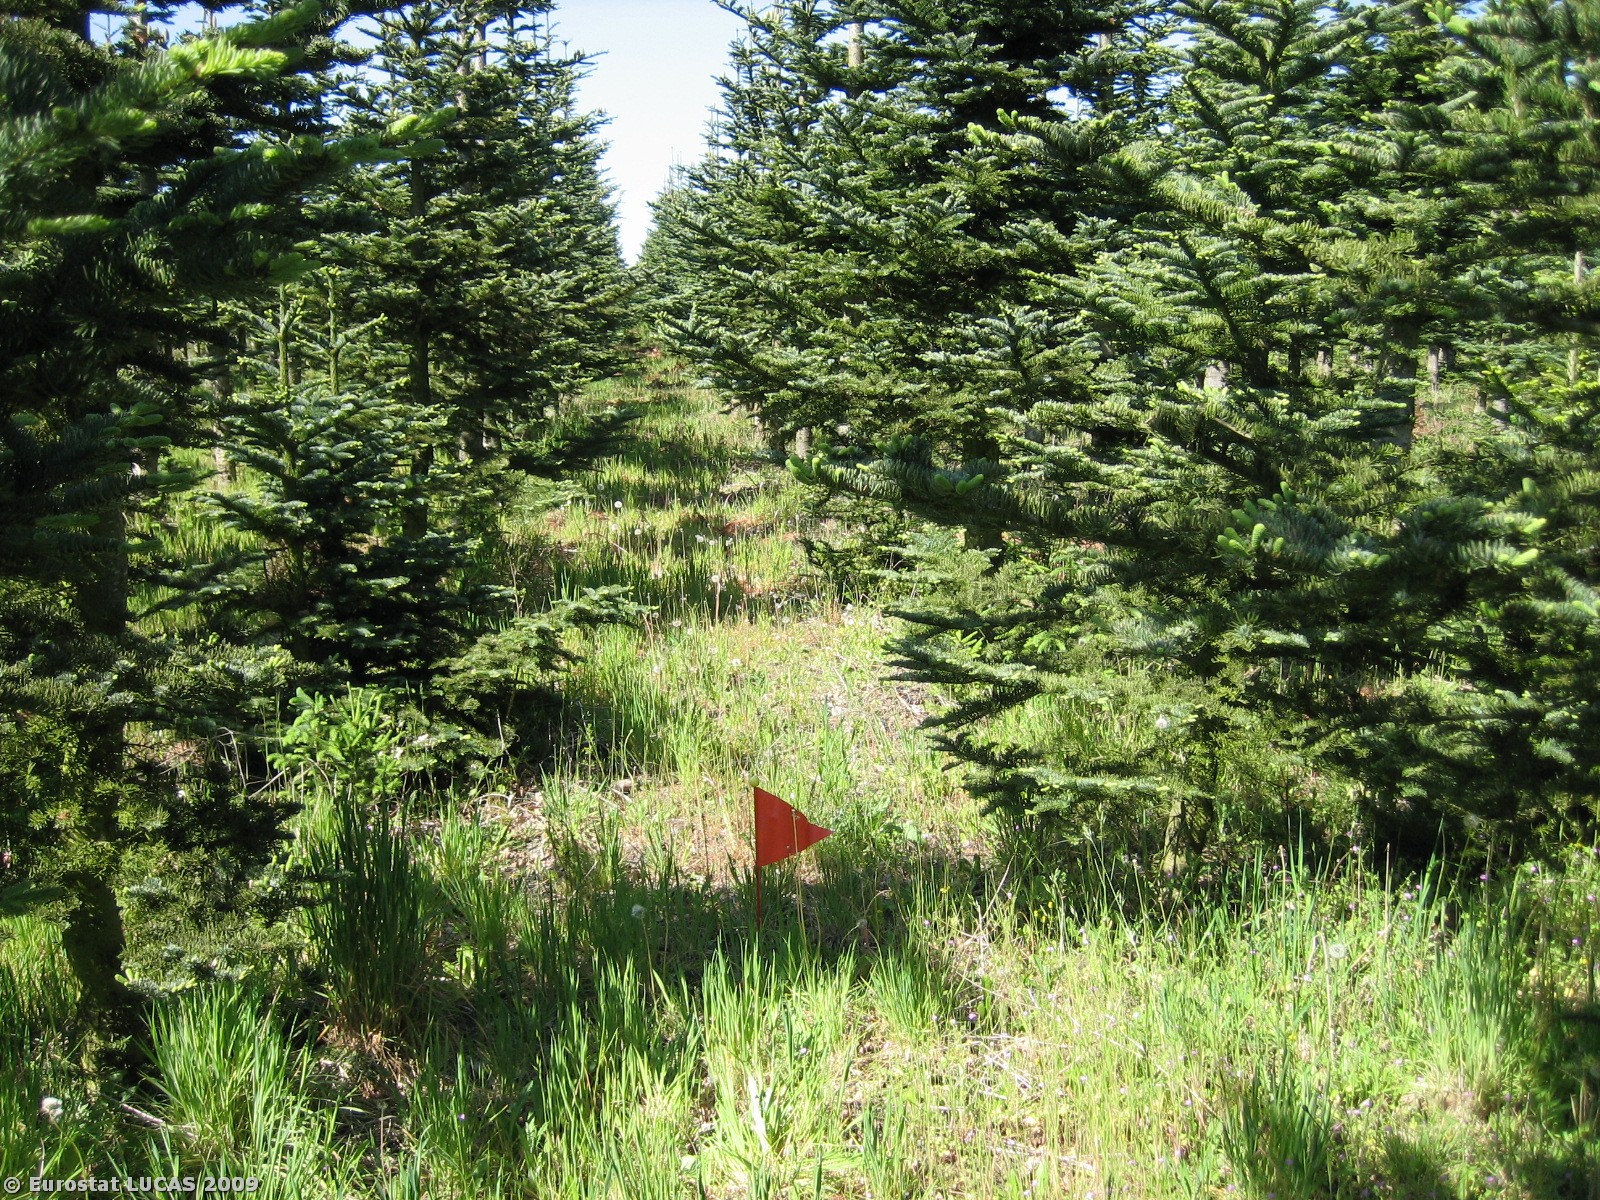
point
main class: Woodland
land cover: Coniferous woodland
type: hemiboreal forest and nemoral coniferous forest and mixed broadleaved-coniferous forest
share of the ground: 25 - 50 %
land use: Forestry
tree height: > 5 m
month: May
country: DK
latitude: 55.8782
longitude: 8.9940
